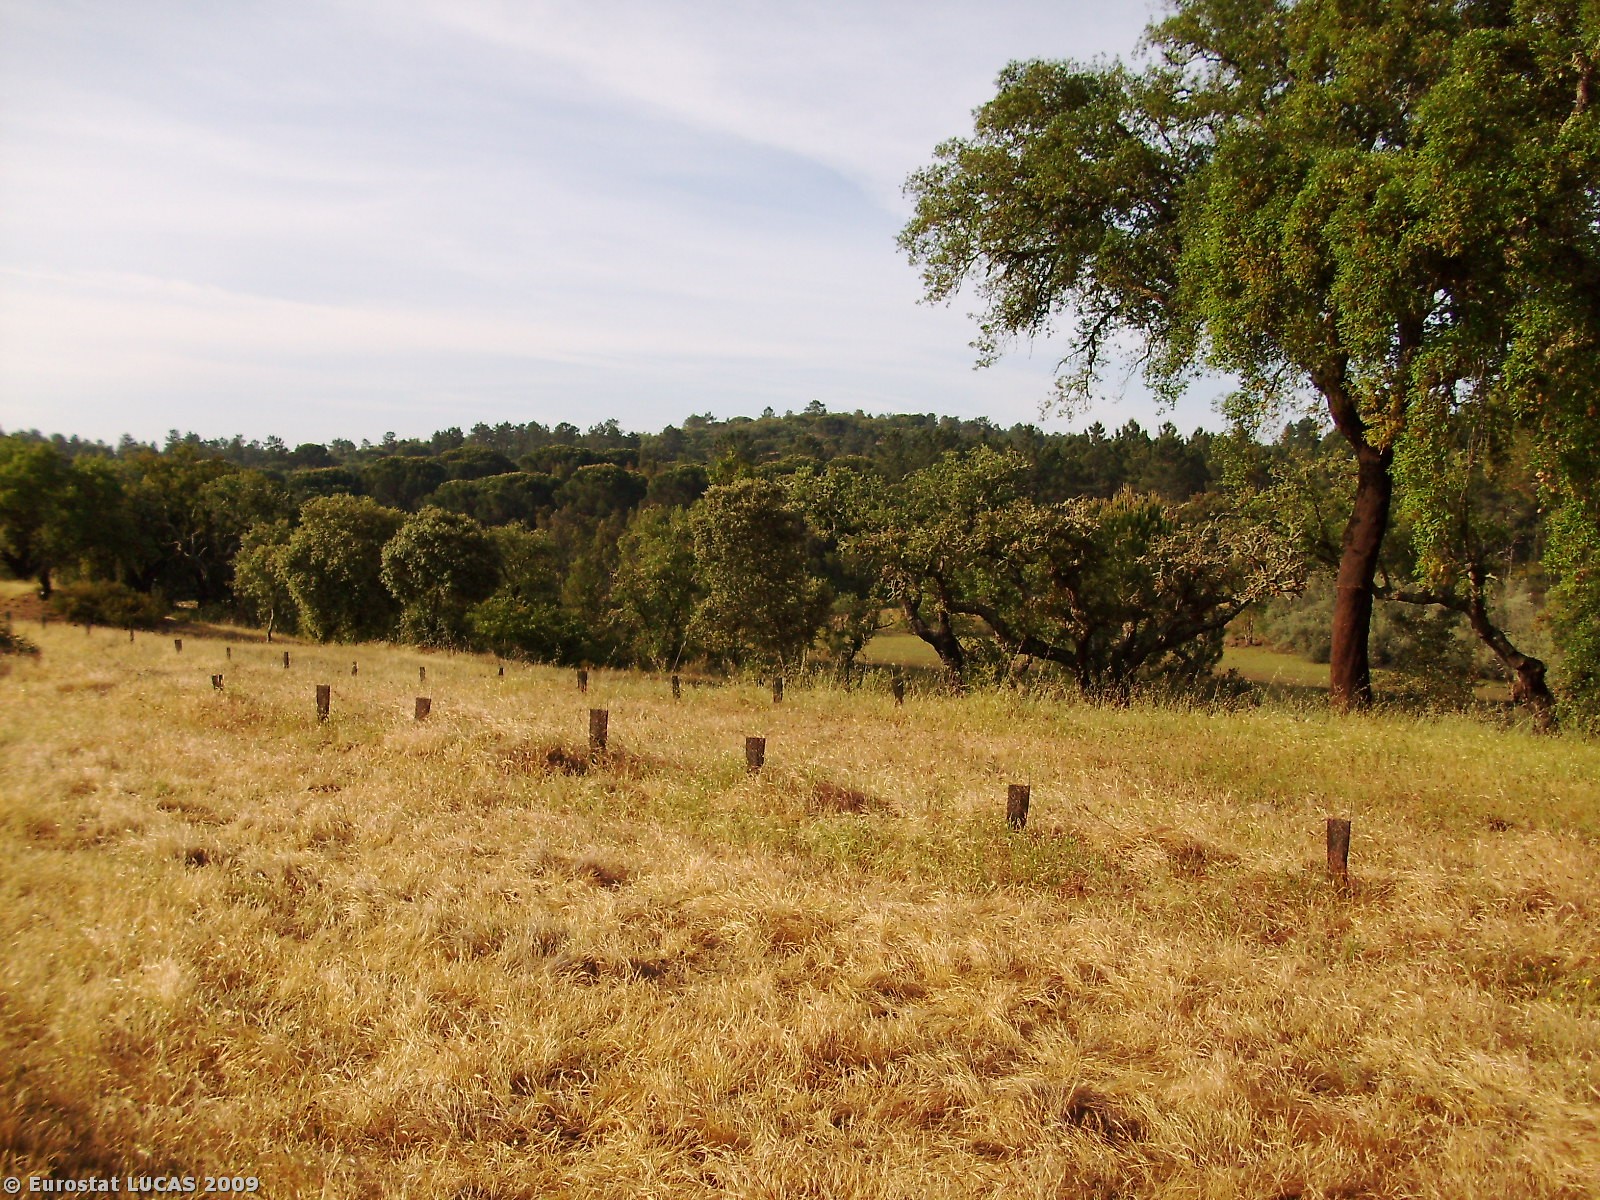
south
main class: Woodland
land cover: Broadleaved woodland
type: broadleaved evergreen forest
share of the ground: 10 - 25 %
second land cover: Grassland with sparse tree/shrub cover
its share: > 75 %
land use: Forestry
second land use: Agriculture (excluding fallow land and kitchen gardens)
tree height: > 5 m
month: May
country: PT
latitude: 39.0898
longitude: -8.0777
